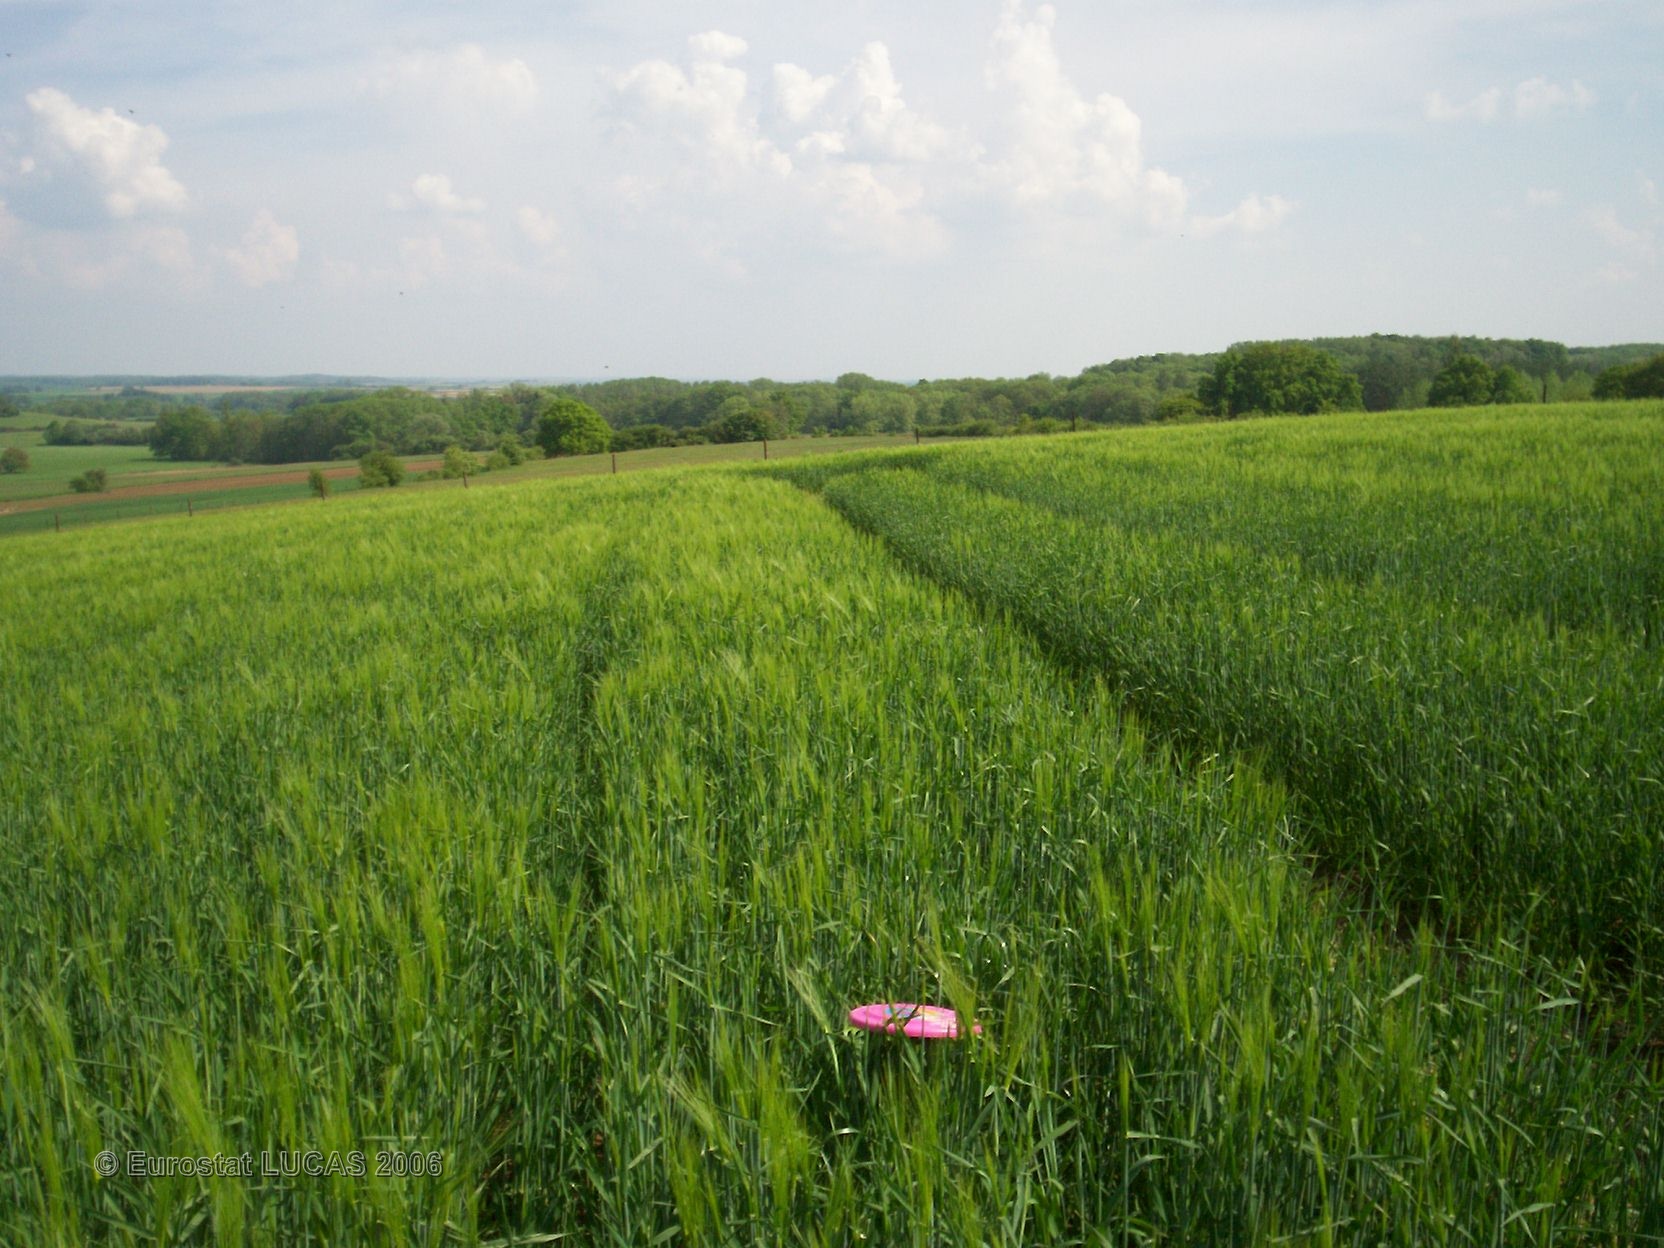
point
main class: Cropland
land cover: Barley
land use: Agriculture (excluding fallow land and kitchen gardens)
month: May
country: FR
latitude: 49.6632
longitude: 4.3015
